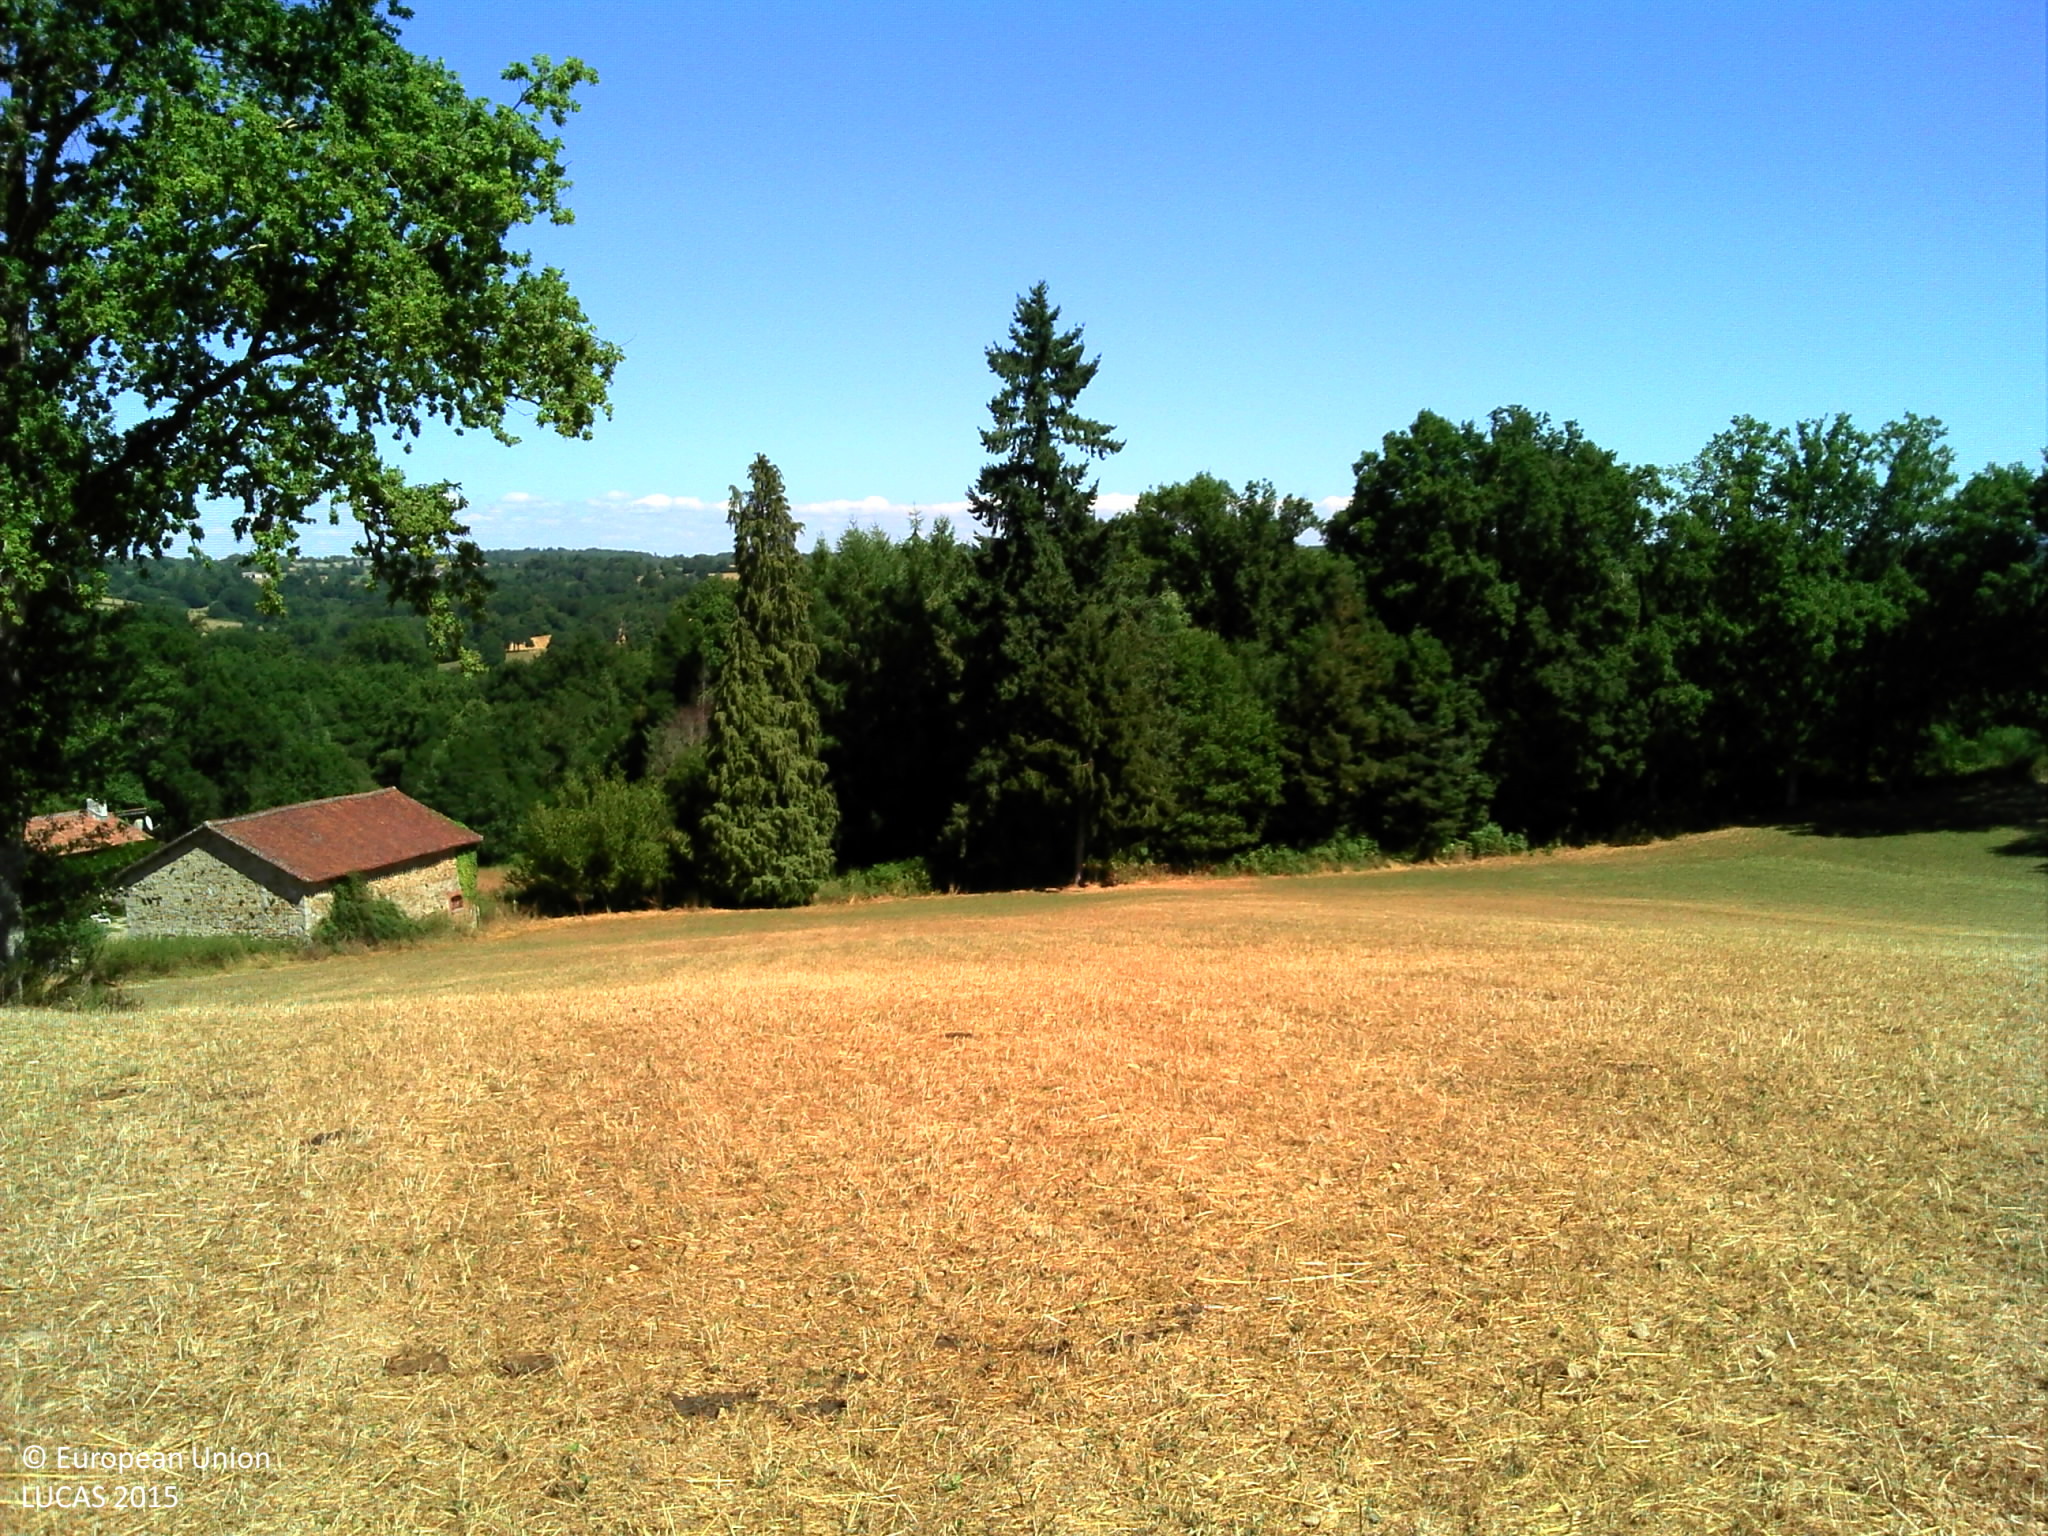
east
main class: Grassland
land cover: Grassland without tree/shrub cover
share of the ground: > 75 %
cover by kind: herbaceous plants 95 %
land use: Agriculture (excluding fallow land and kitchen gardens)
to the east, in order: Grassland without tree/shrub cover; Managed hedges; Fences; Tracks; Fences; Grassland without tree/shrub cover; Spruce dominated mixed woodland; Fences; Spruce dominated mixed woodland
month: July
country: FR
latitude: 45.7722
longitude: 1.4404
